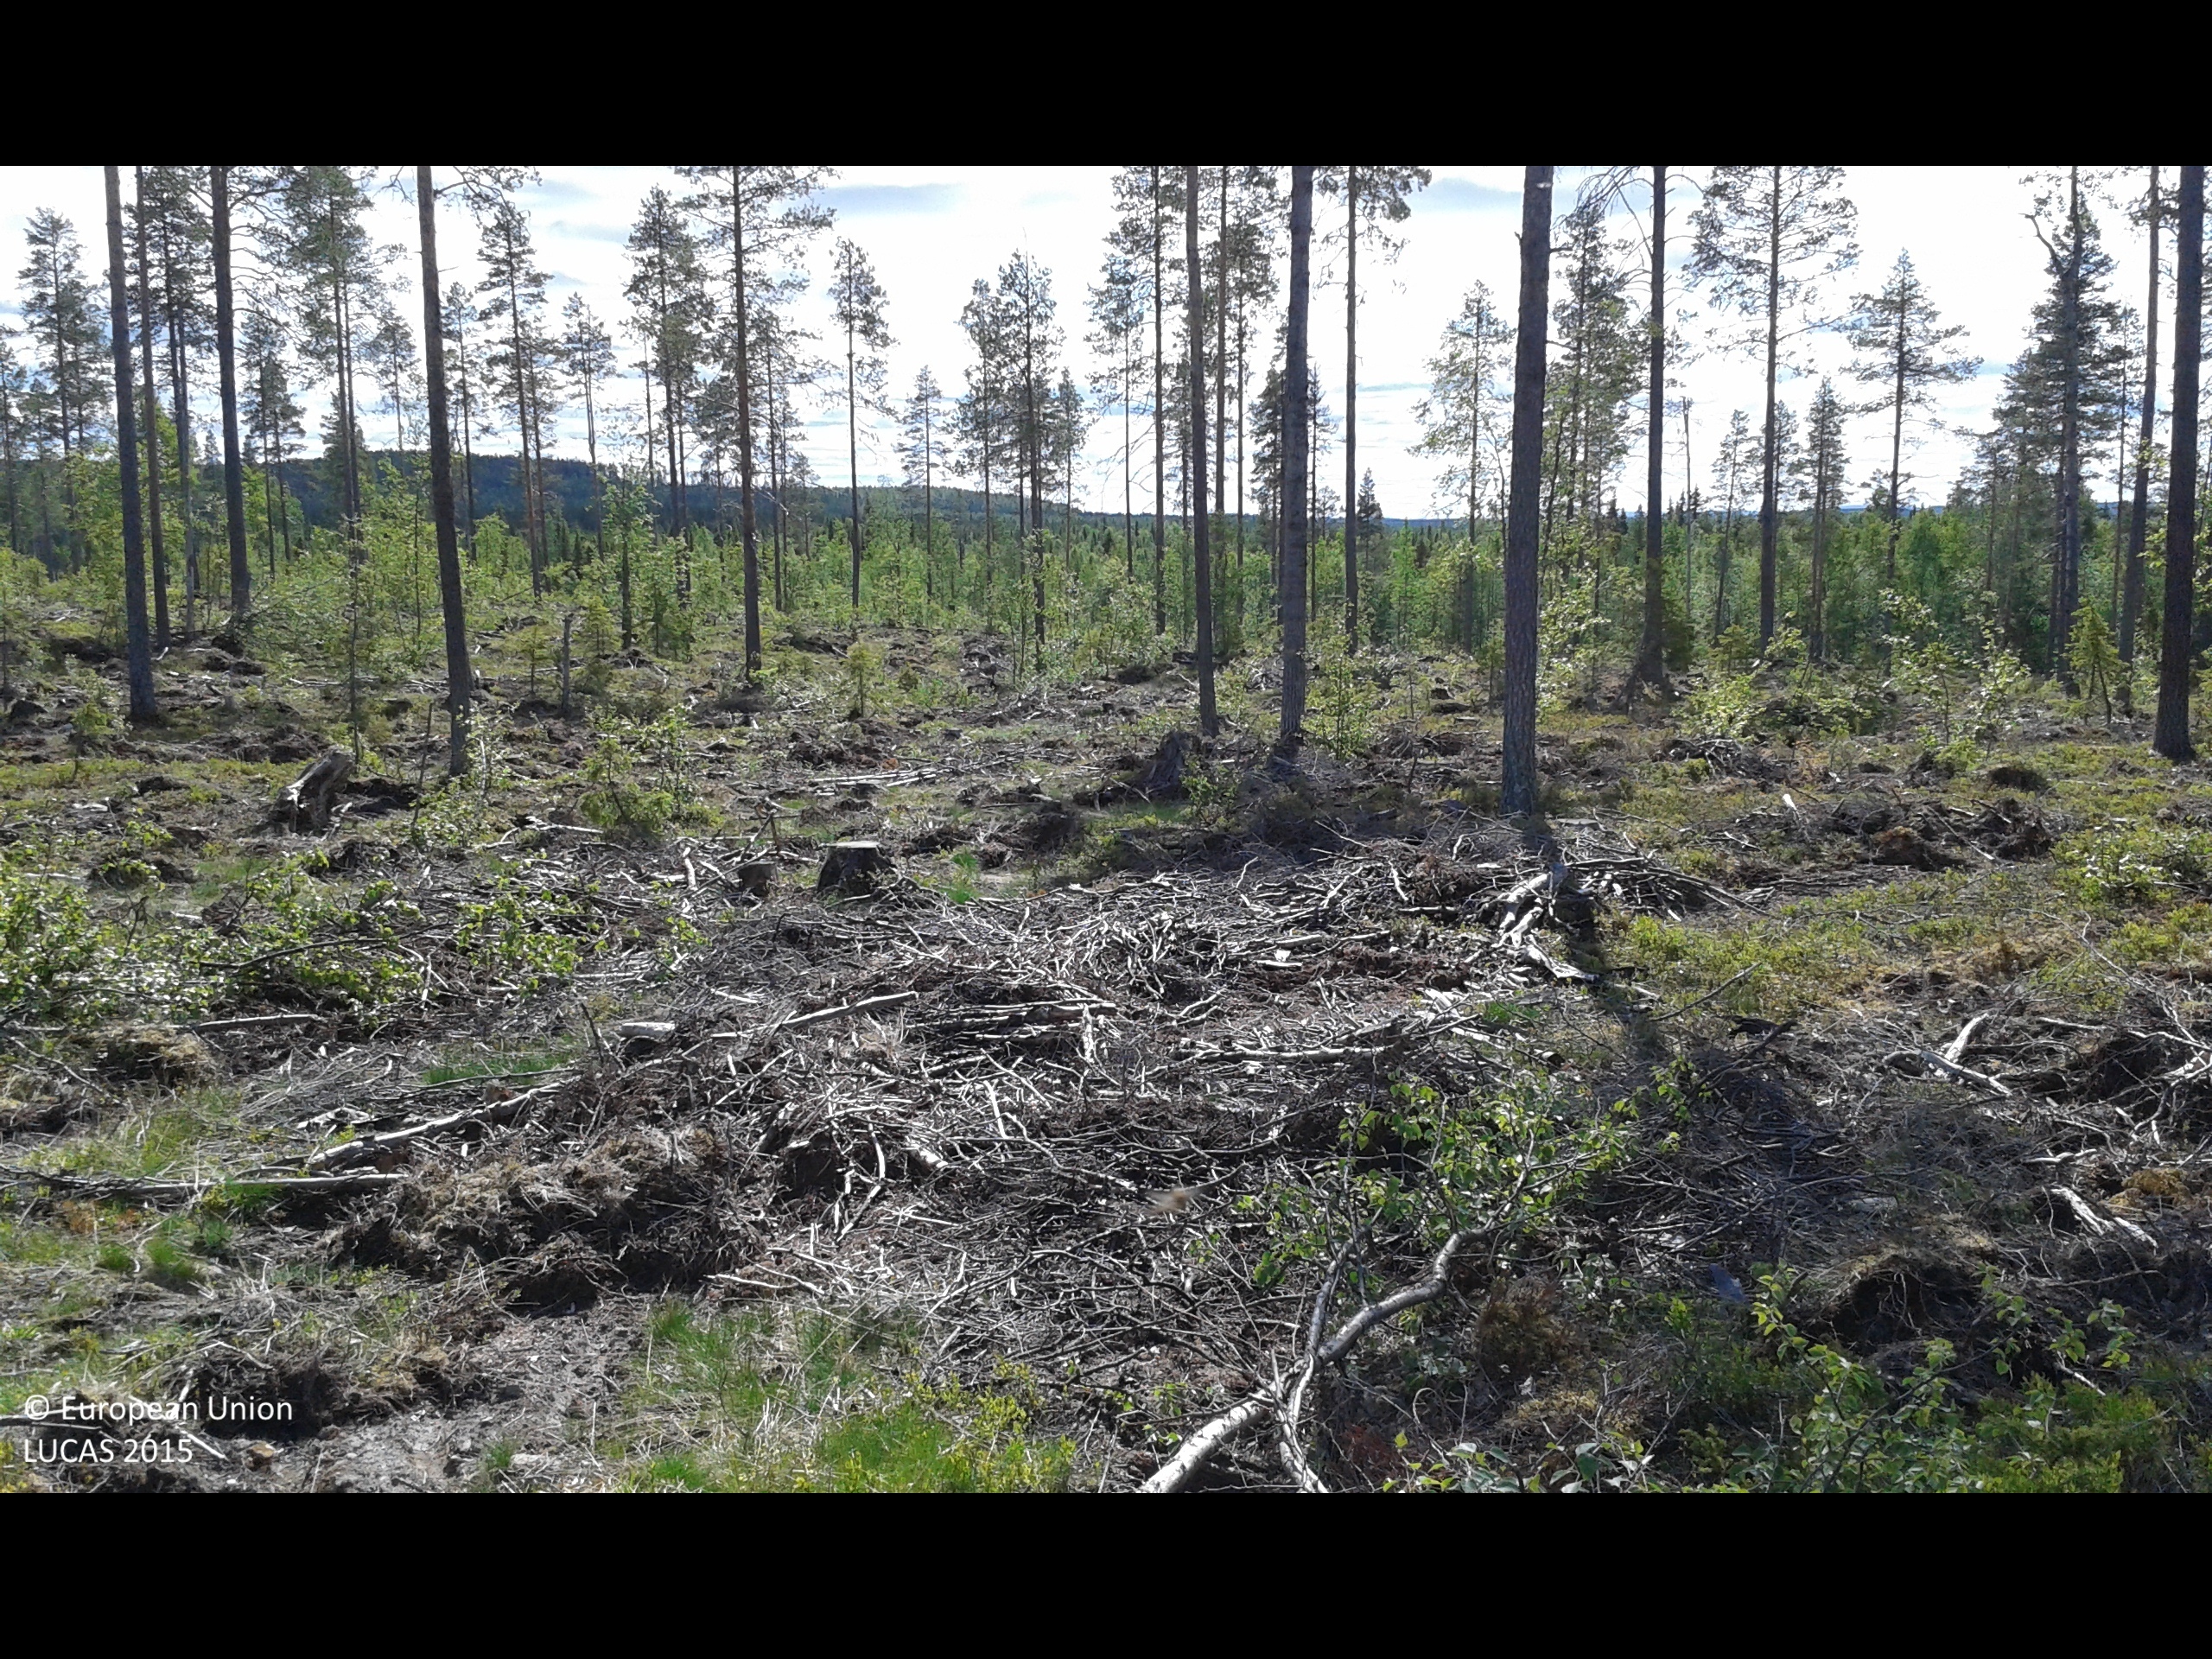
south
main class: Woodland
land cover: Pine dominated mixed woodland
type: boreal forest
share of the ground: 10 - 25 %
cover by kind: unconsolidated bare surface 50 %, shrubs 35 %, coniferous forest trees 10 %, broadleaved forest trees 5 %
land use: Forestry
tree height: > 5 m
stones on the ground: < 10 %
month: July
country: SE
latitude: 67.0349
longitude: 23.0854
